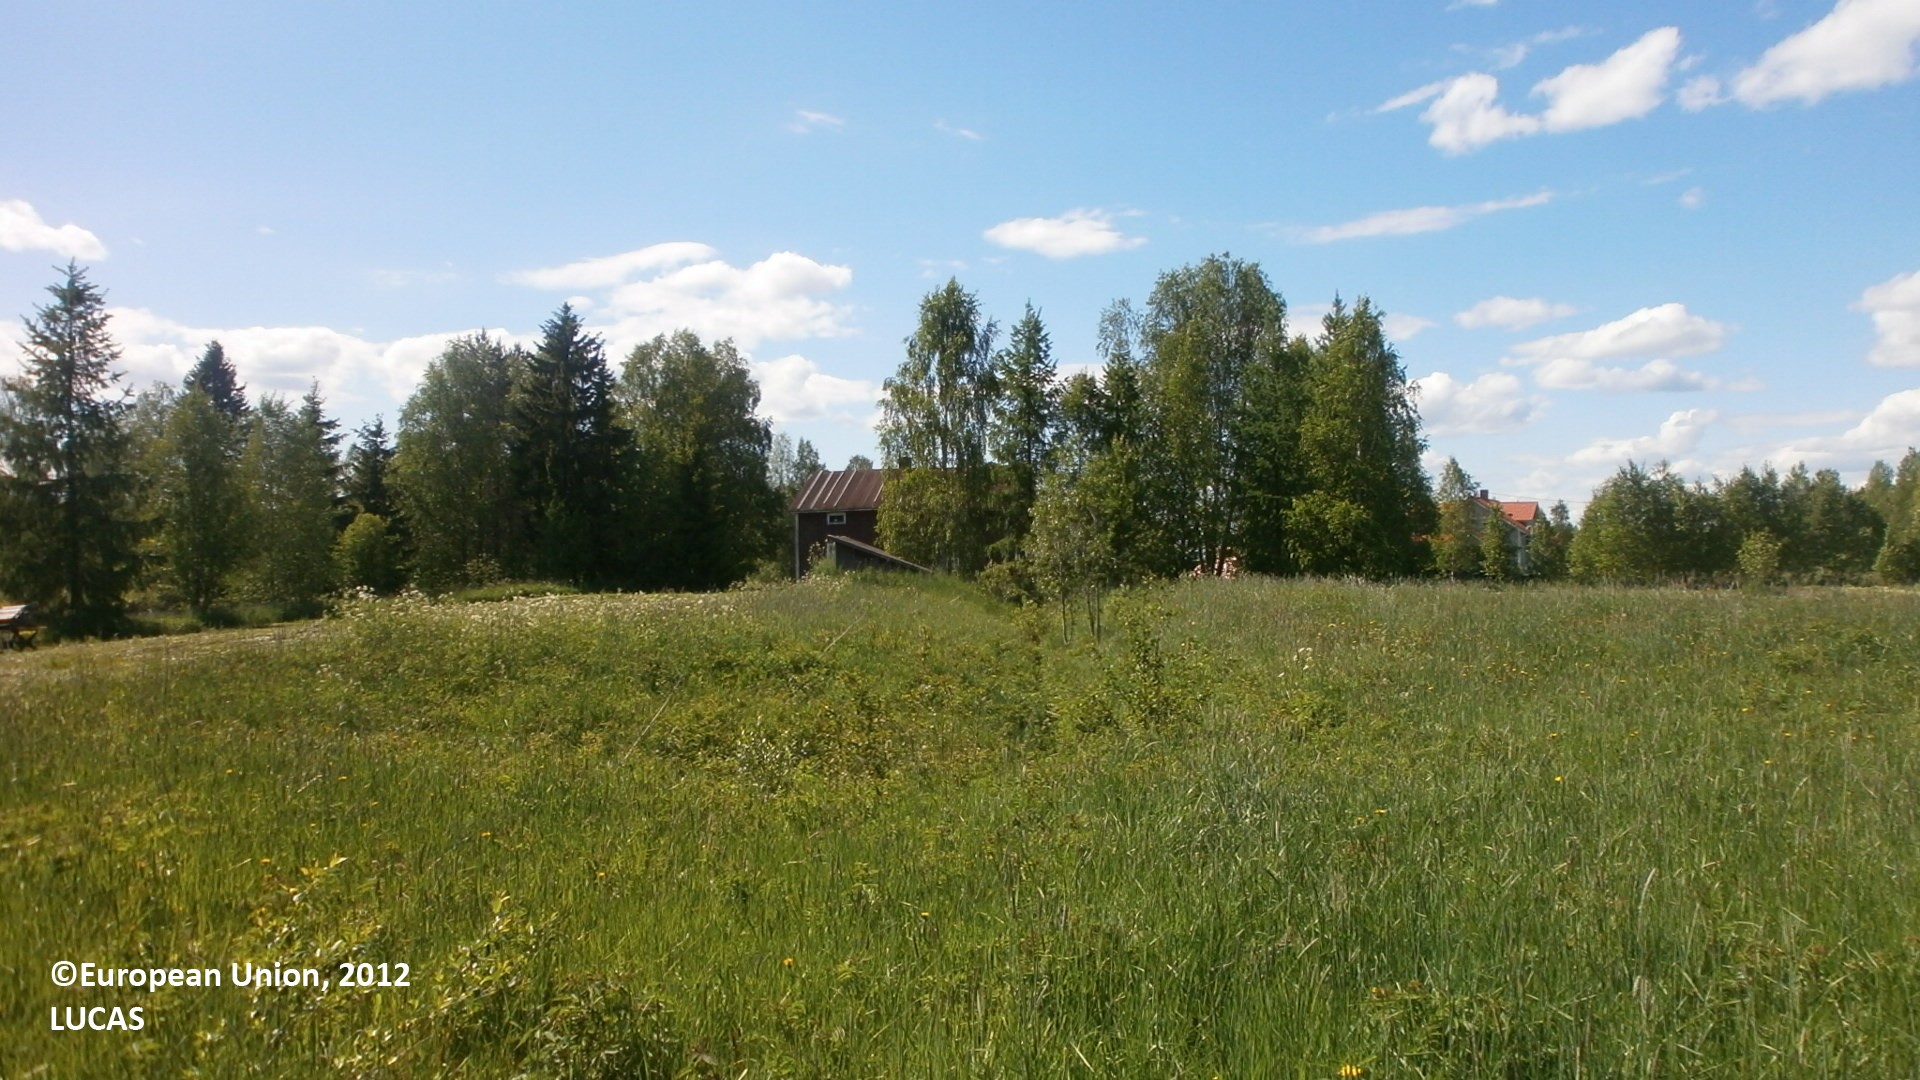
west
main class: Grassland
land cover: Grassland without tree/shrub cover
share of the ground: > 75 %
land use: Agriculture (excluding fallow land and kitchen gardens)
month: June
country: FI
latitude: 63.9803
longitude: 25.6897
